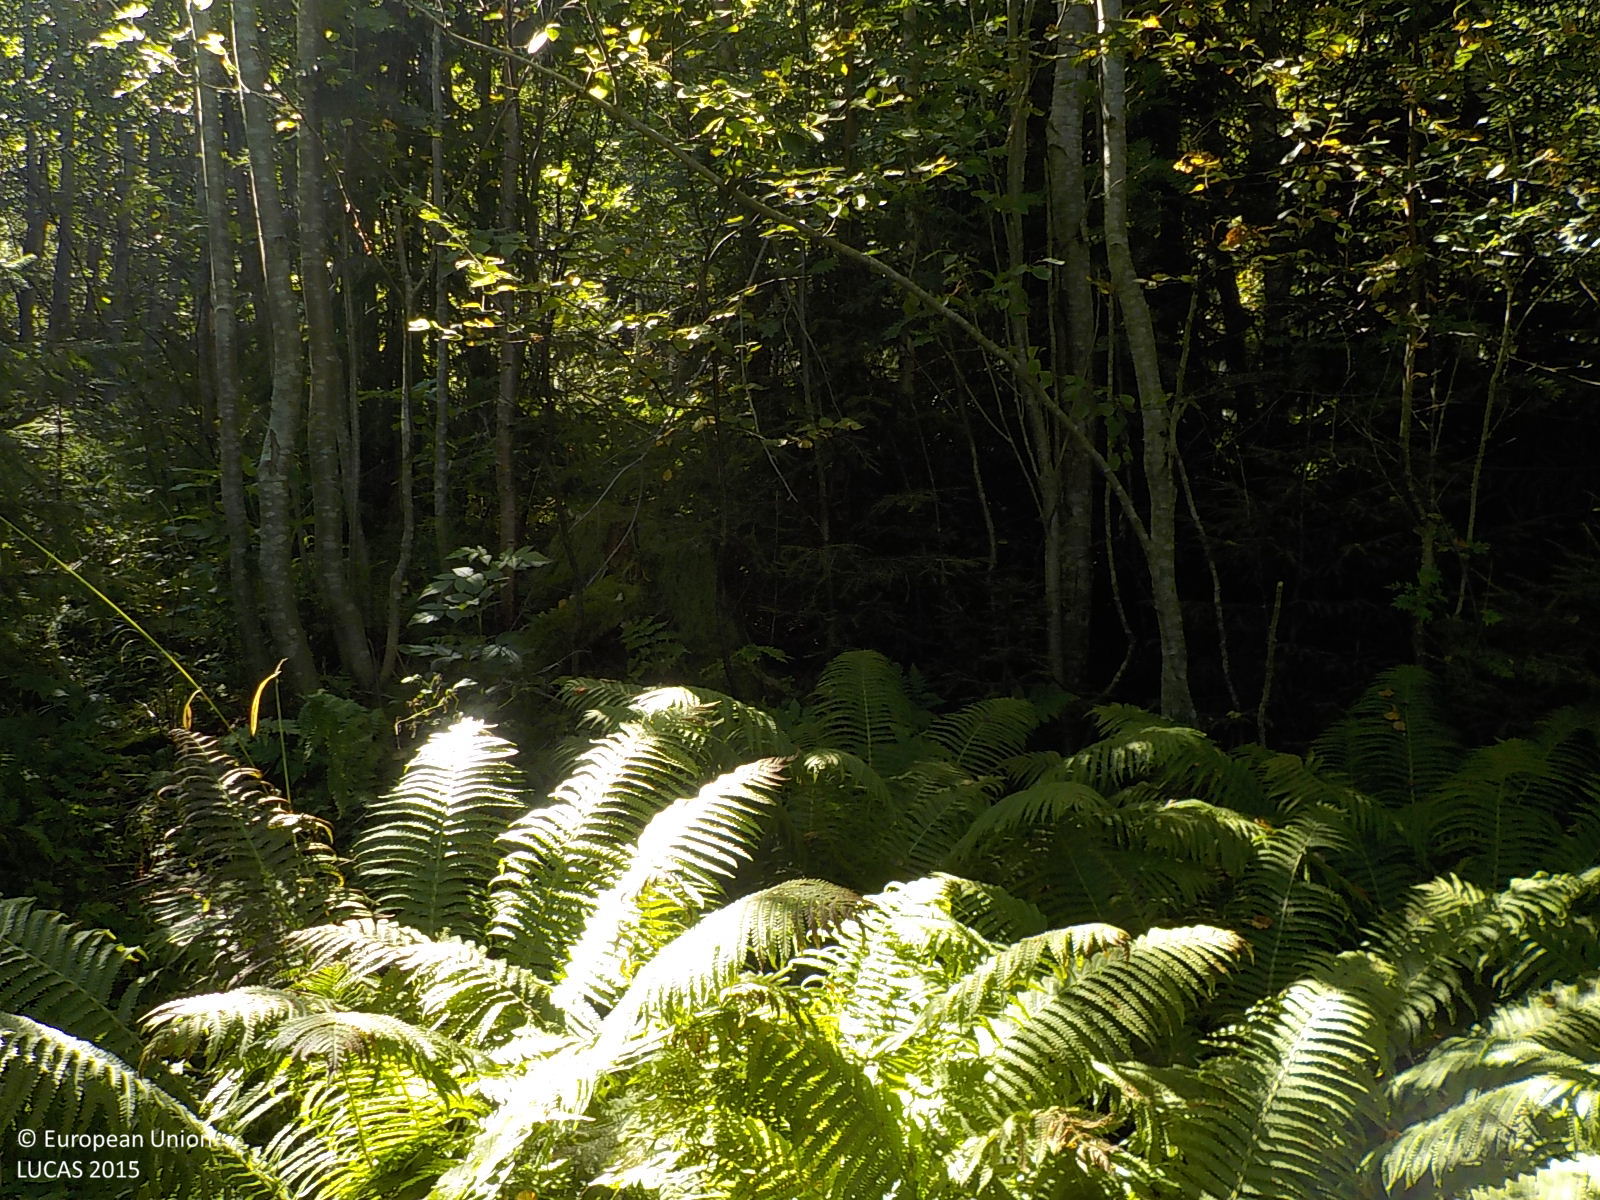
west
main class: Woodland
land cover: Broadleaved woodland
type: hemiboreal forest and nemoral coniferous forest and mixed broadleaved-coniferous forest
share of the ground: > 75 %
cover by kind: broadleaved forest trees 85 %, herbaceous plants 15 %
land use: Forestry
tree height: > 5 m
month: August
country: SE
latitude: 63.1530
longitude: 18.4931
